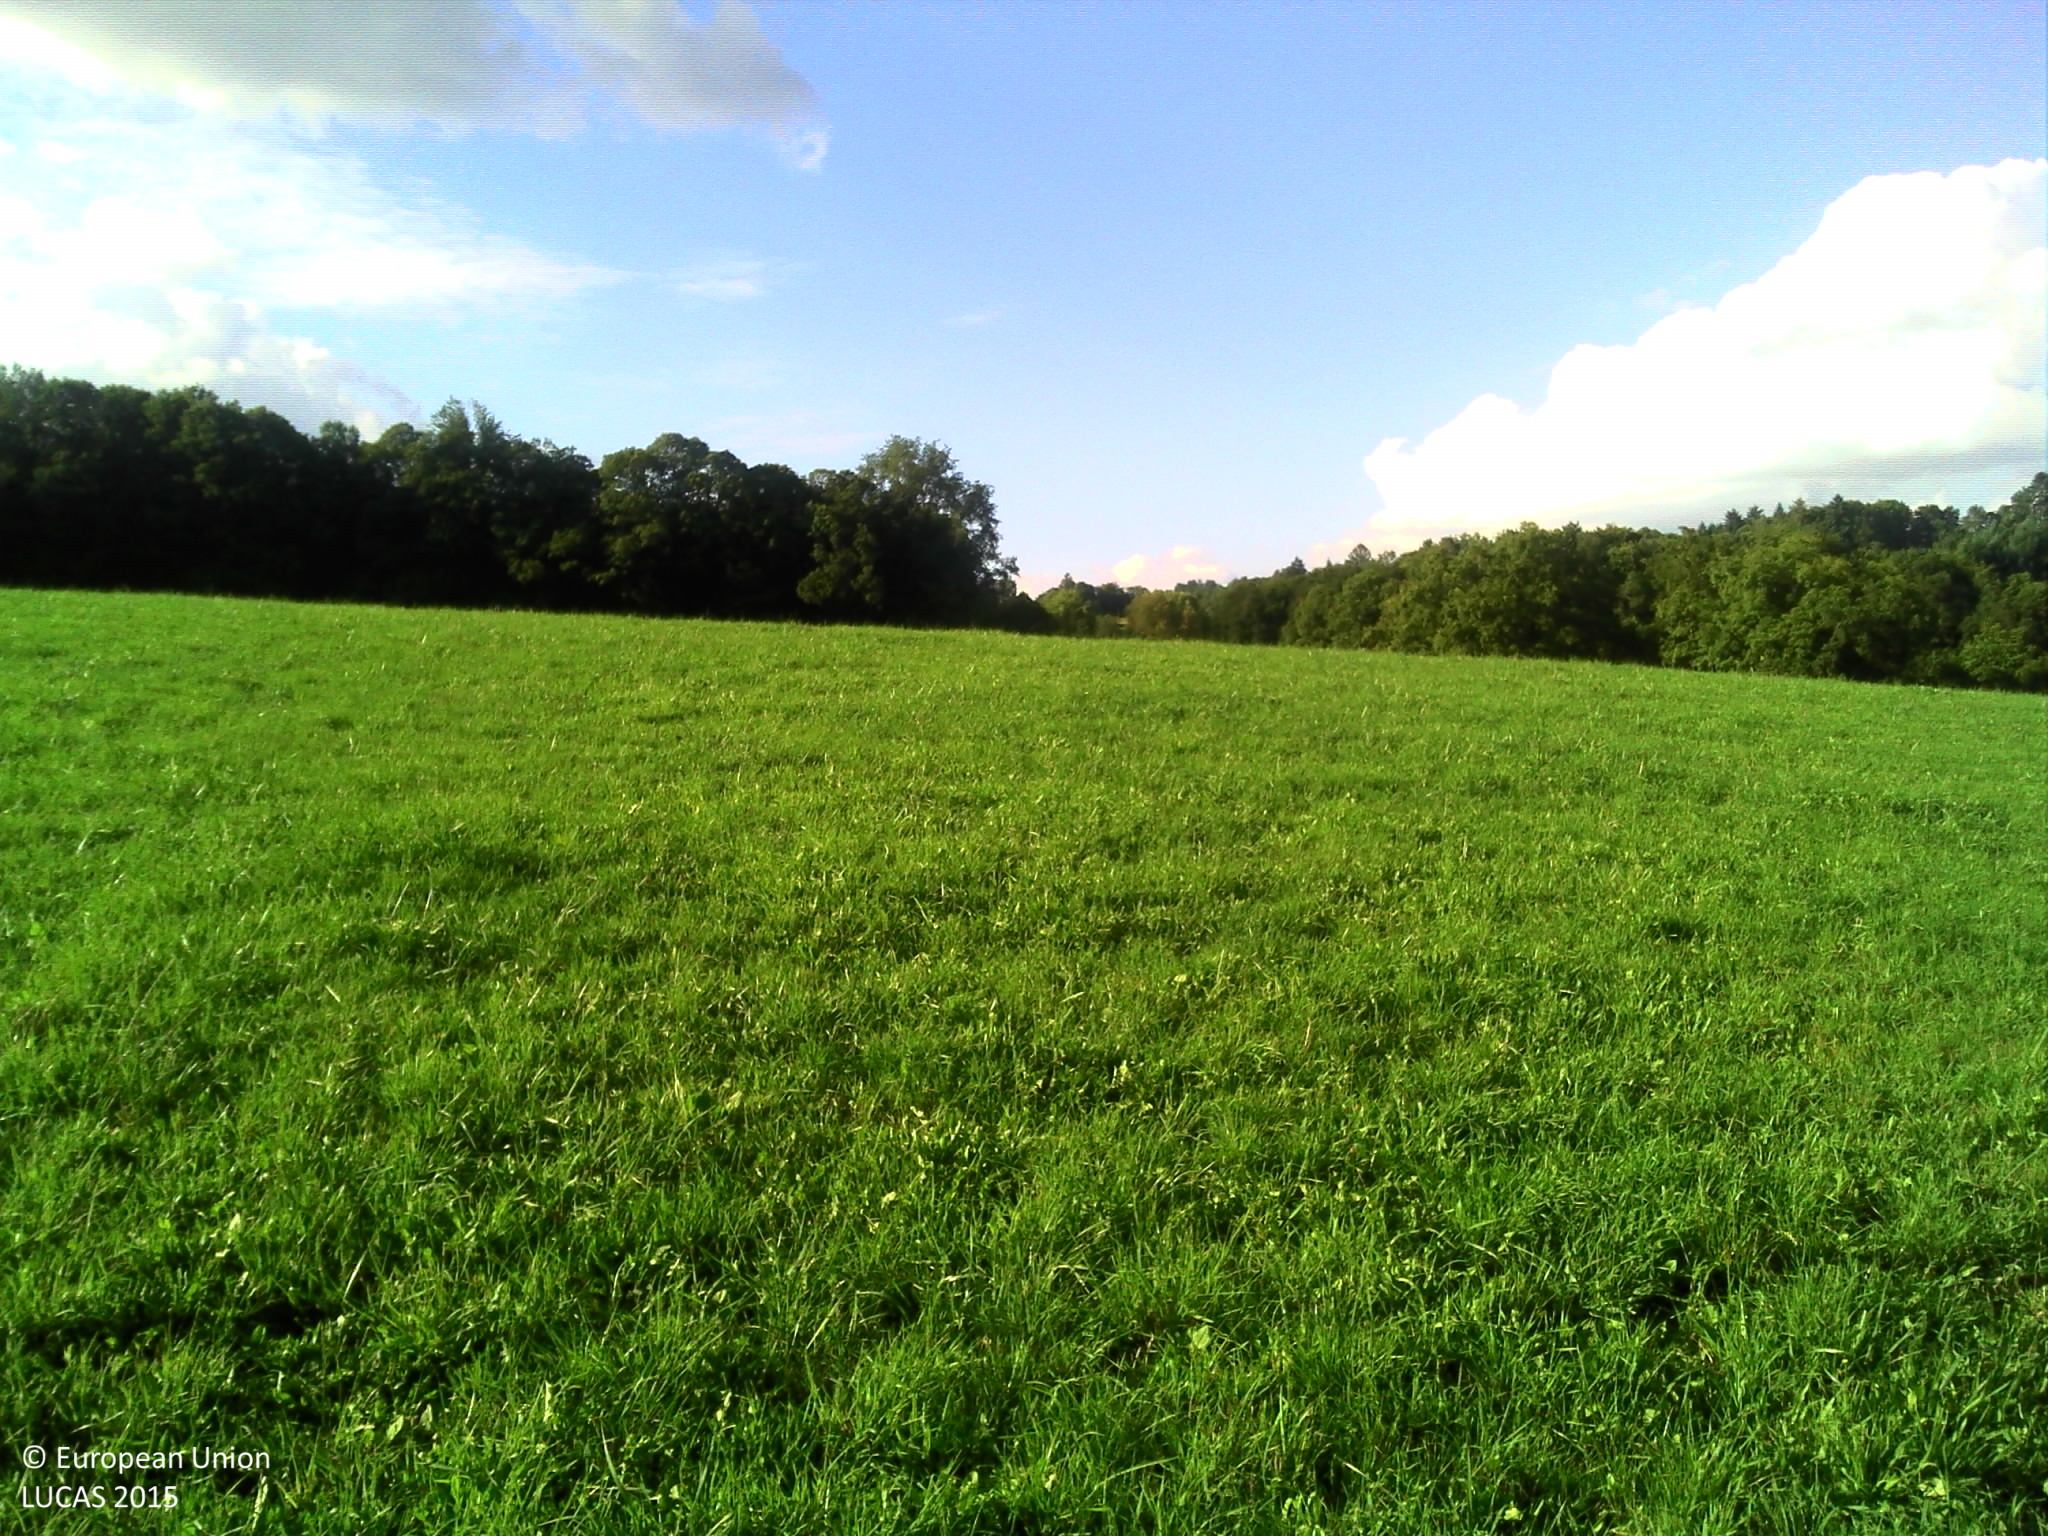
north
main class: Grassland
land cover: Grassland without tree/shrub cover
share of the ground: > 75 %
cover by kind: herbaceous plants 100 %
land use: Agriculture (excluding fallow land and kitchen gardens)
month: August
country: FR
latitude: 45.9019
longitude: 1.7051
